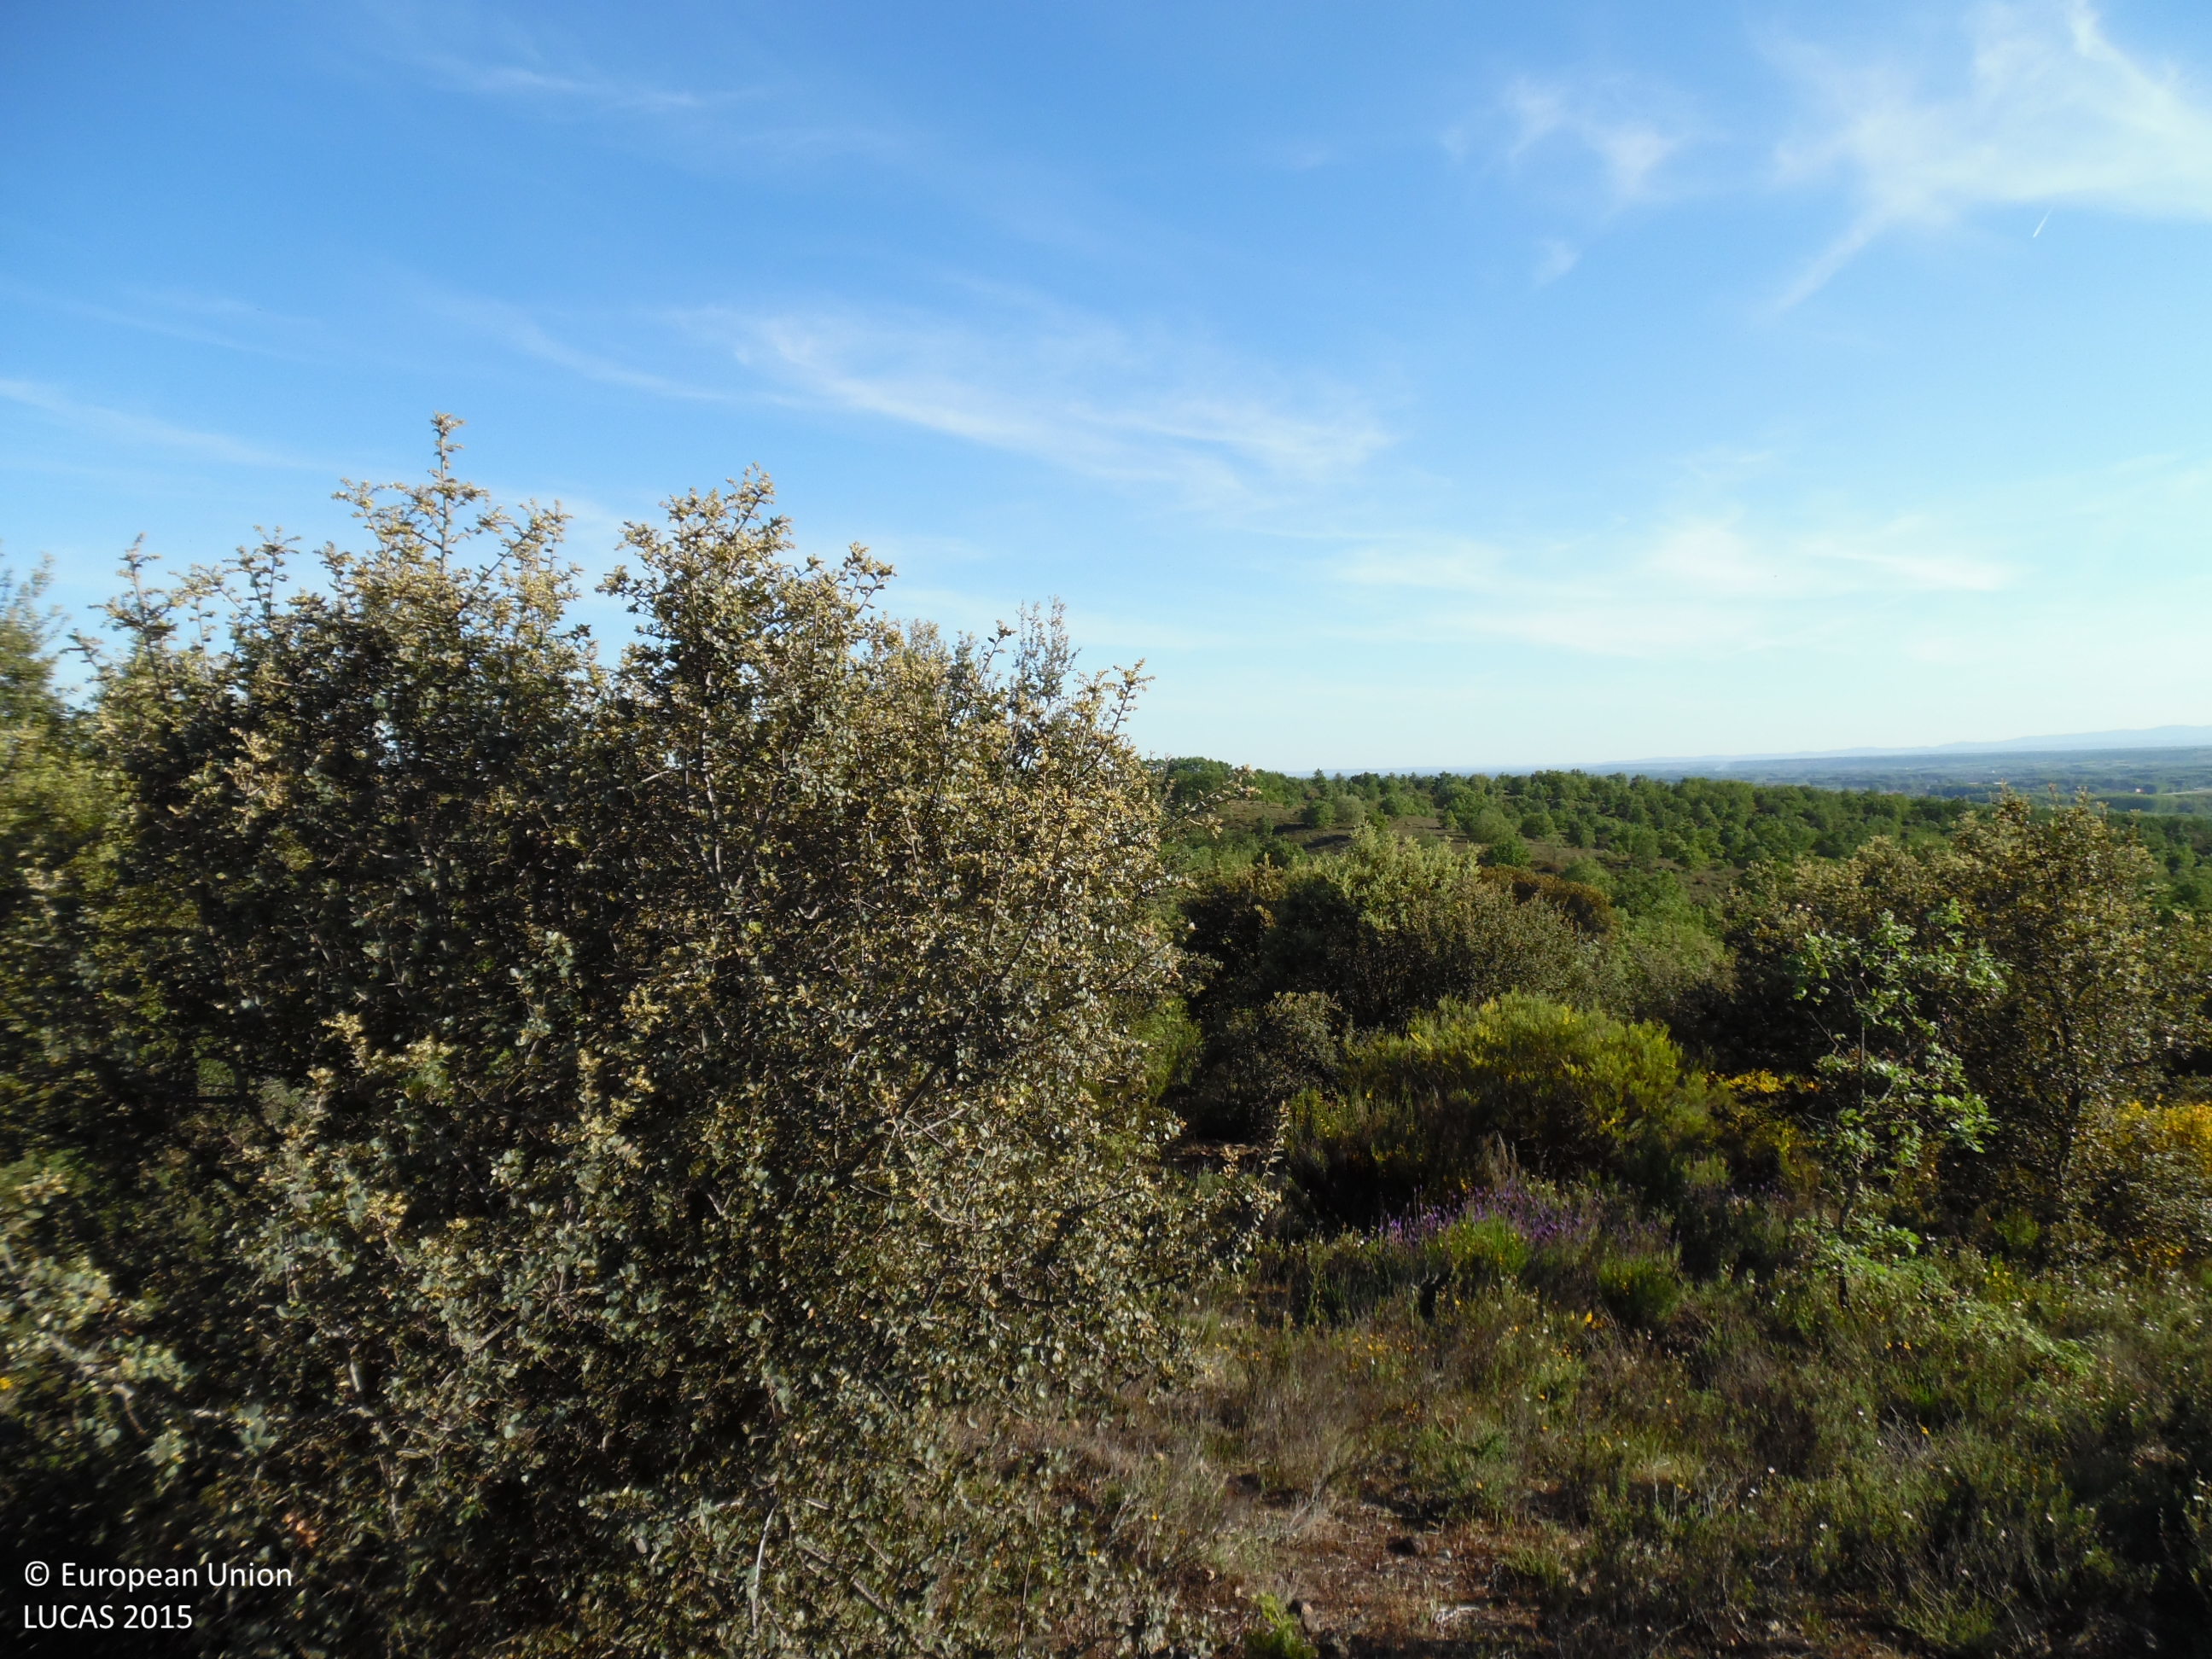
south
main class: Woodland
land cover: Broadleaved woodland
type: acidophilous oak and oak-birch forest
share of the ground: > 75 %
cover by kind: broadleaved forest trees 70 %, shrubs 20 %, herbaceous plants 10 %
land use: Abandoned areas
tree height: < 5 m
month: May
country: ES
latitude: 42.6180
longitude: -5.7925
